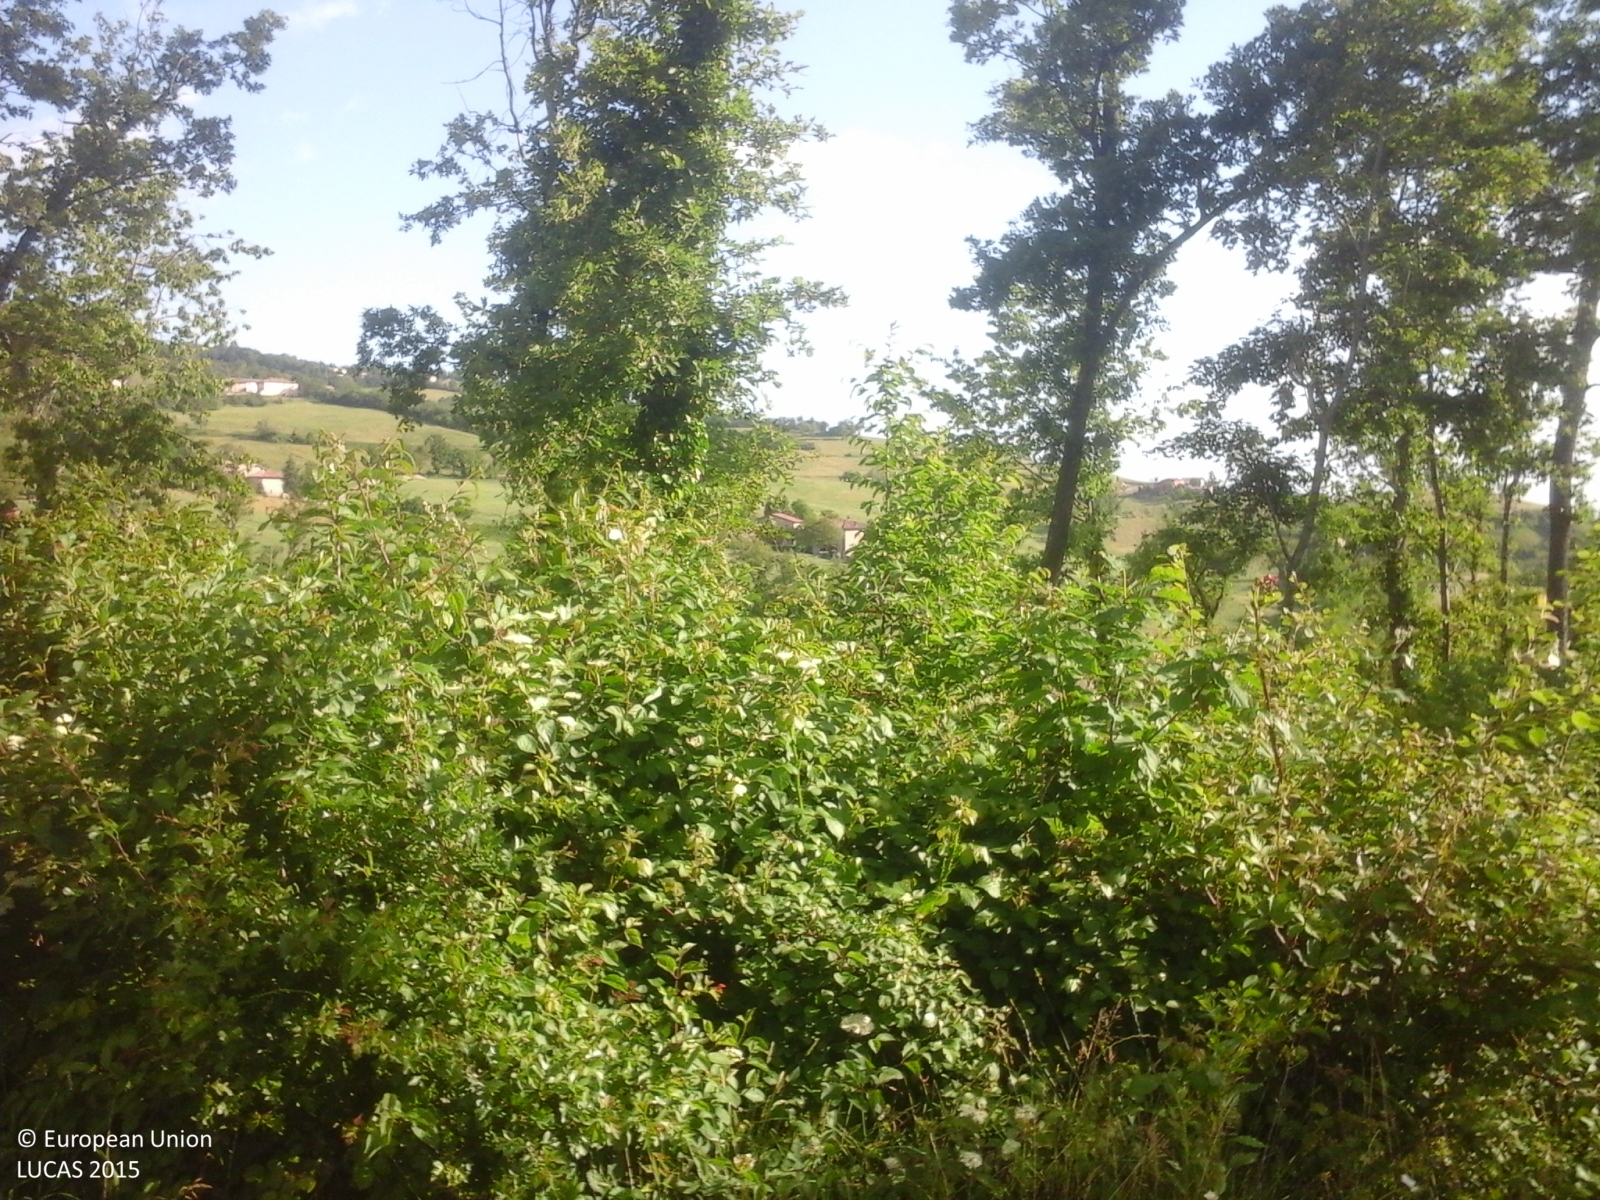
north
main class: Cropland
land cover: Common wheat
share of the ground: > 75 %
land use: Agriculture (excluding fallow land and kitchen gardens)
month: May
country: IT
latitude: 44.3273
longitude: 11.0384
